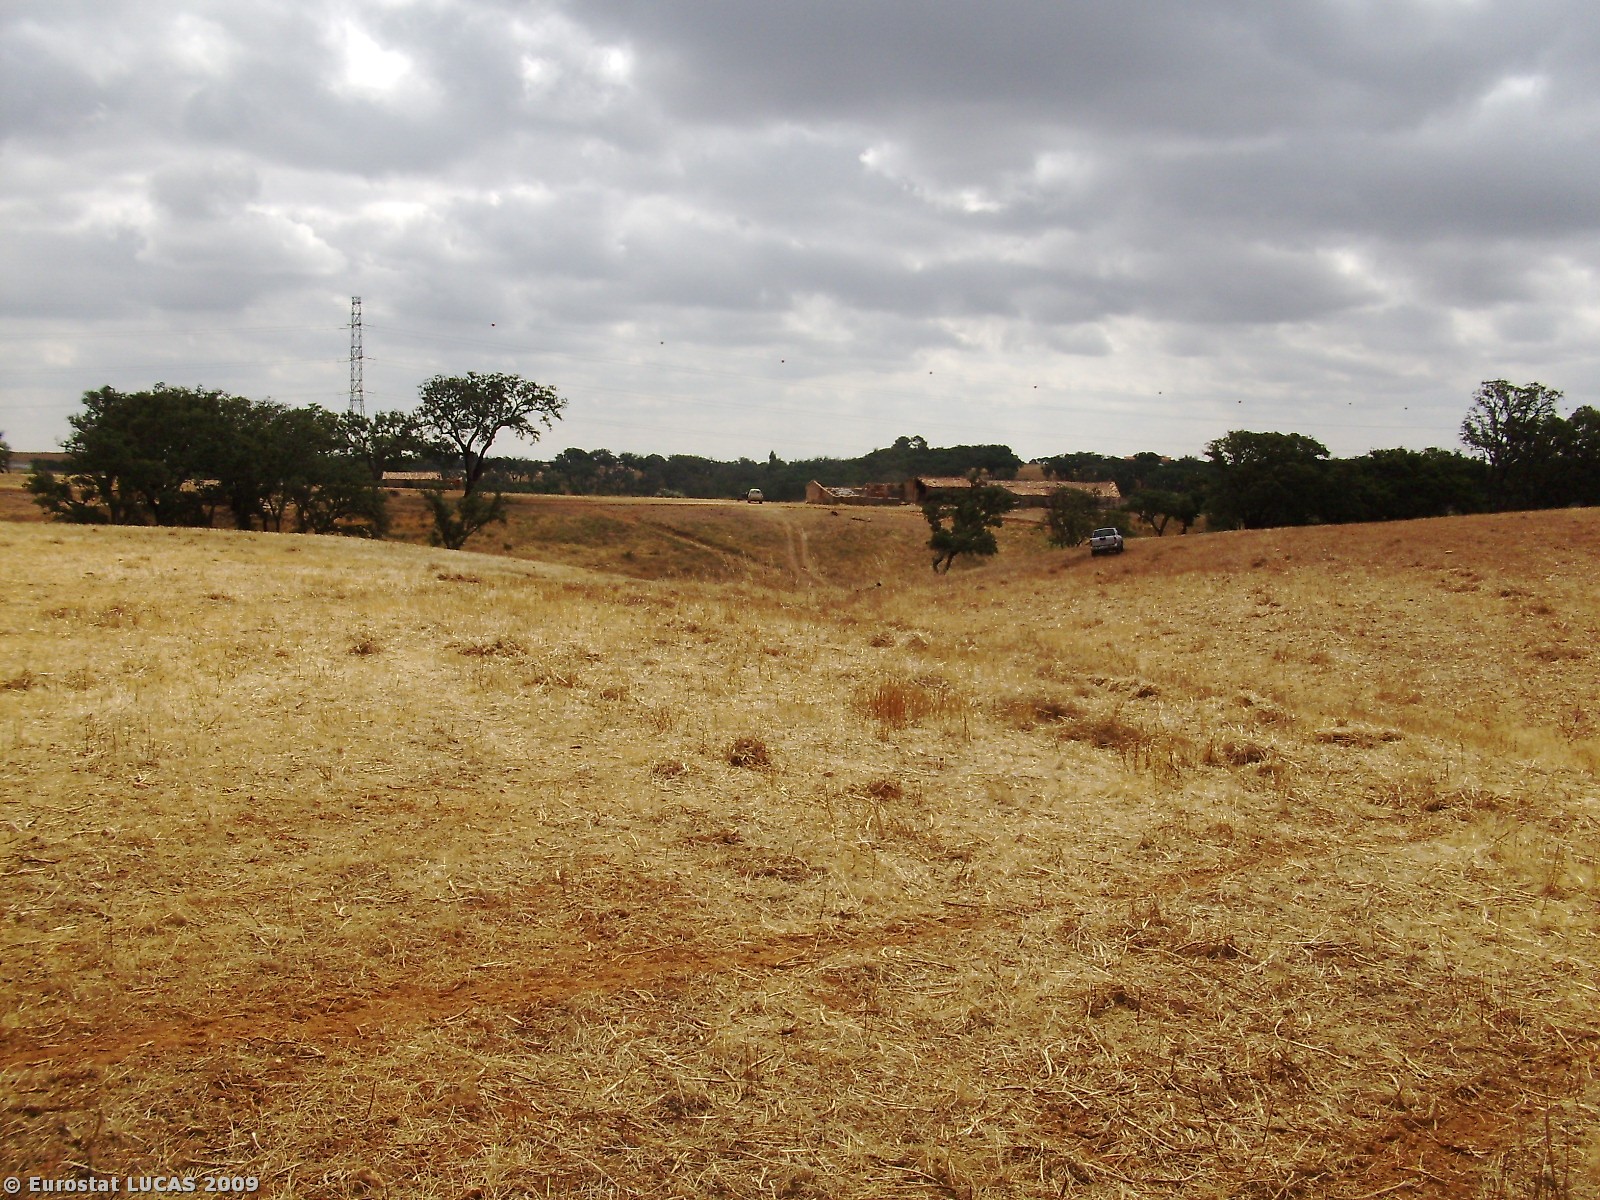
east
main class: Grassland
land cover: Spontaneously vegetated surfaces
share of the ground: > 75 %
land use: Fallow land
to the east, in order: Spontaneously vegetated surfaces; Rivers and streams; Spontaneously vegetated surfaces; Tracks; Spontaneously vegetated surfaces
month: June
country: PT
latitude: 37.8634
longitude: -8.6750
